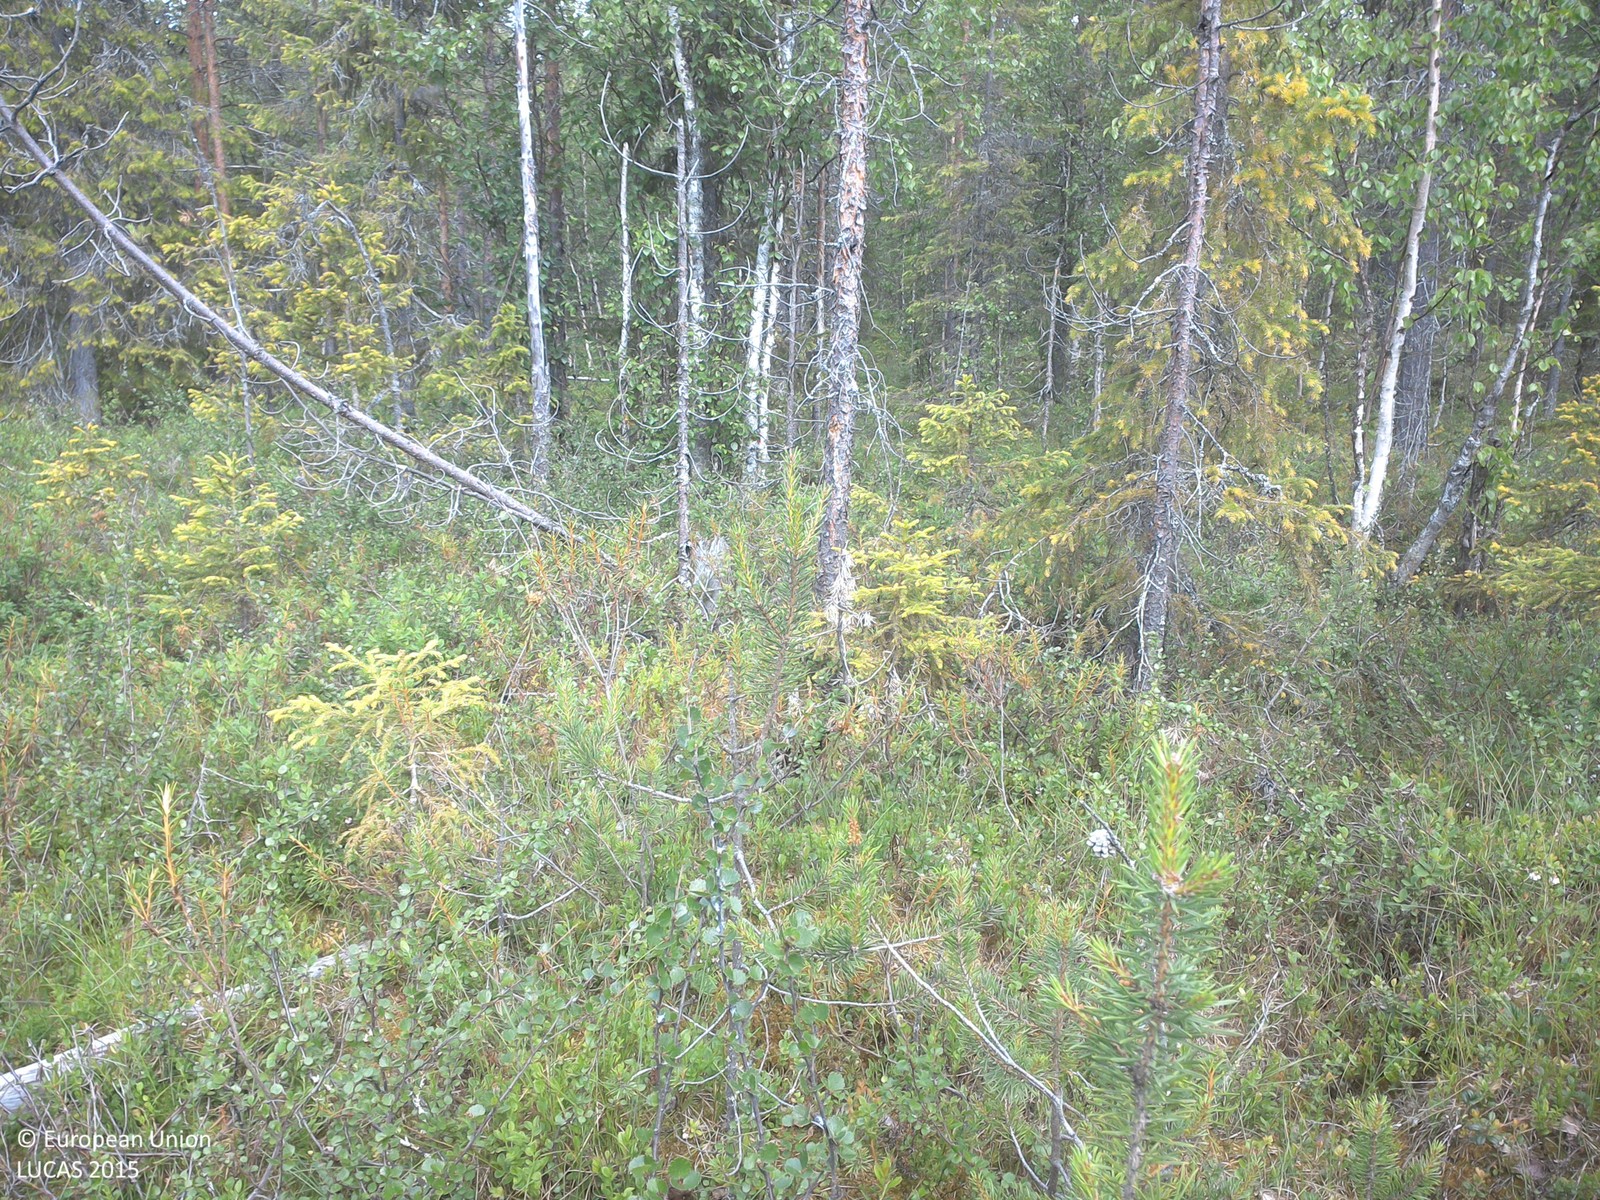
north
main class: Woodland
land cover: Pine dominated mixed woodland
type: boreal forest
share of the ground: 25 - 50 %
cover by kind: herbaceous plants 35 %, shrubs 30 %, coniferous forest trees 20 %, broadleaved forest trees 10 %, lichens and mosses 5 %
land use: Forestry
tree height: > 5 m
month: July
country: SE
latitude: 67.4386
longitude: 23.3512
